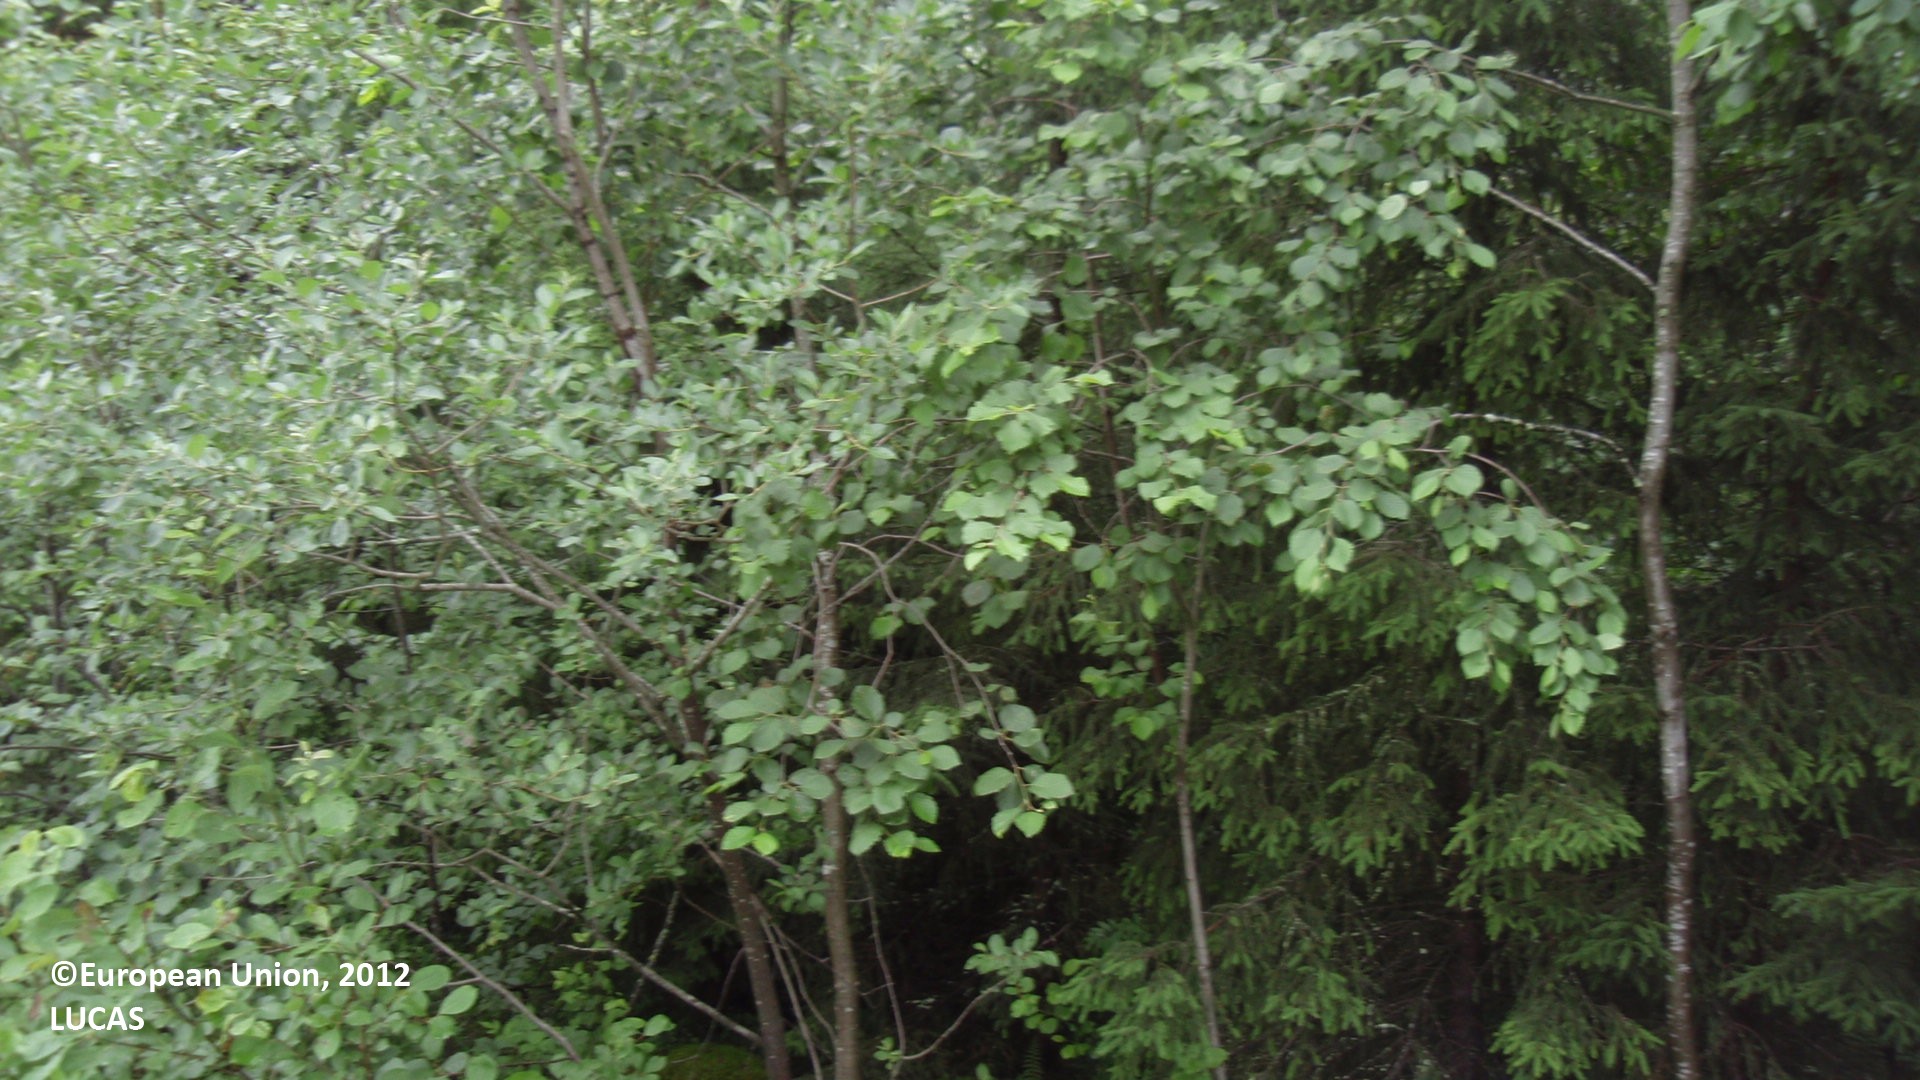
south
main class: Grassland
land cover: Grassland with sparse tree/shrub cover
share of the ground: > 75 %
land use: Road transport
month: July
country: FI
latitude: 61.5156
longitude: 27.2166
